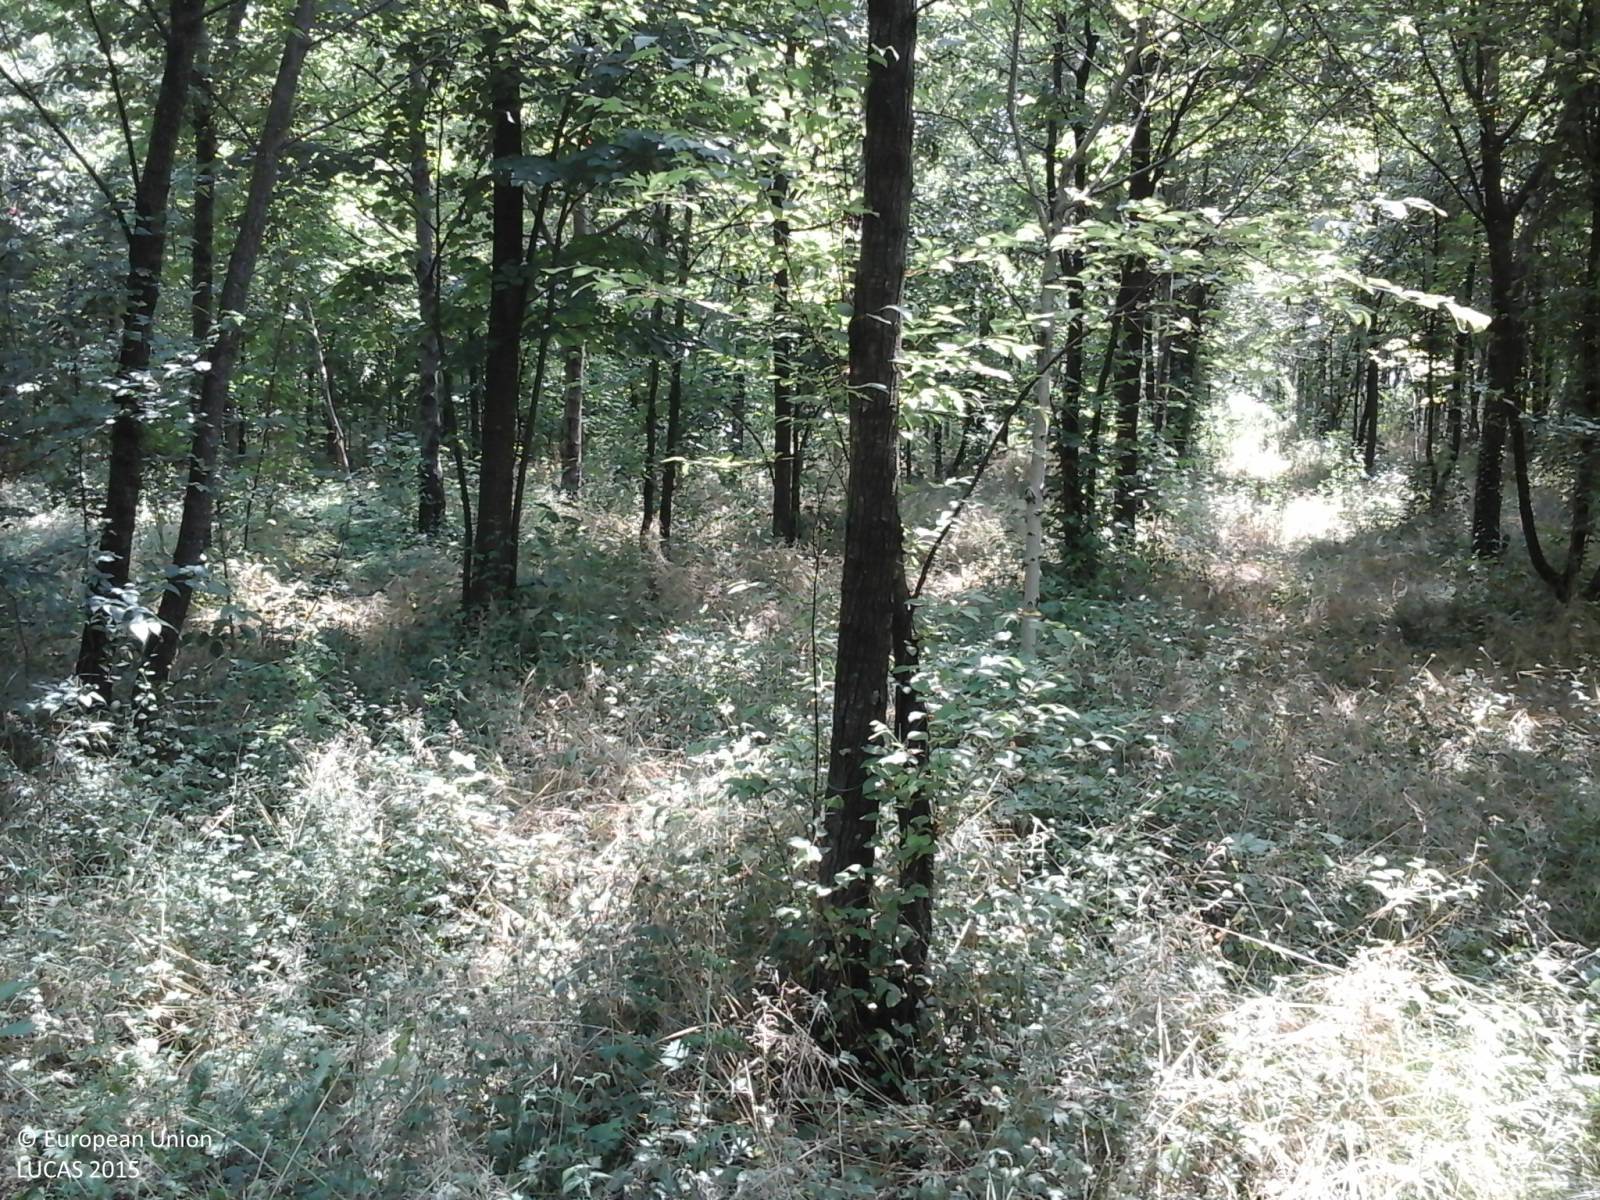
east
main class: Woodland
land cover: Broadleaved woodland
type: mesophytic deciduous forest
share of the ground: > 75 %
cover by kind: broadleaved forest trees 100 %
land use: Forestry
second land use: Agriculture (excluding fallow land and kitchen gardens)
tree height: > 5 m
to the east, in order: Broadleaved woodland; Spontaneously vegetated surfaces; Tracks; Barley; Soya
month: June
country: IT
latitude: 46.0147
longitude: 12.5412
